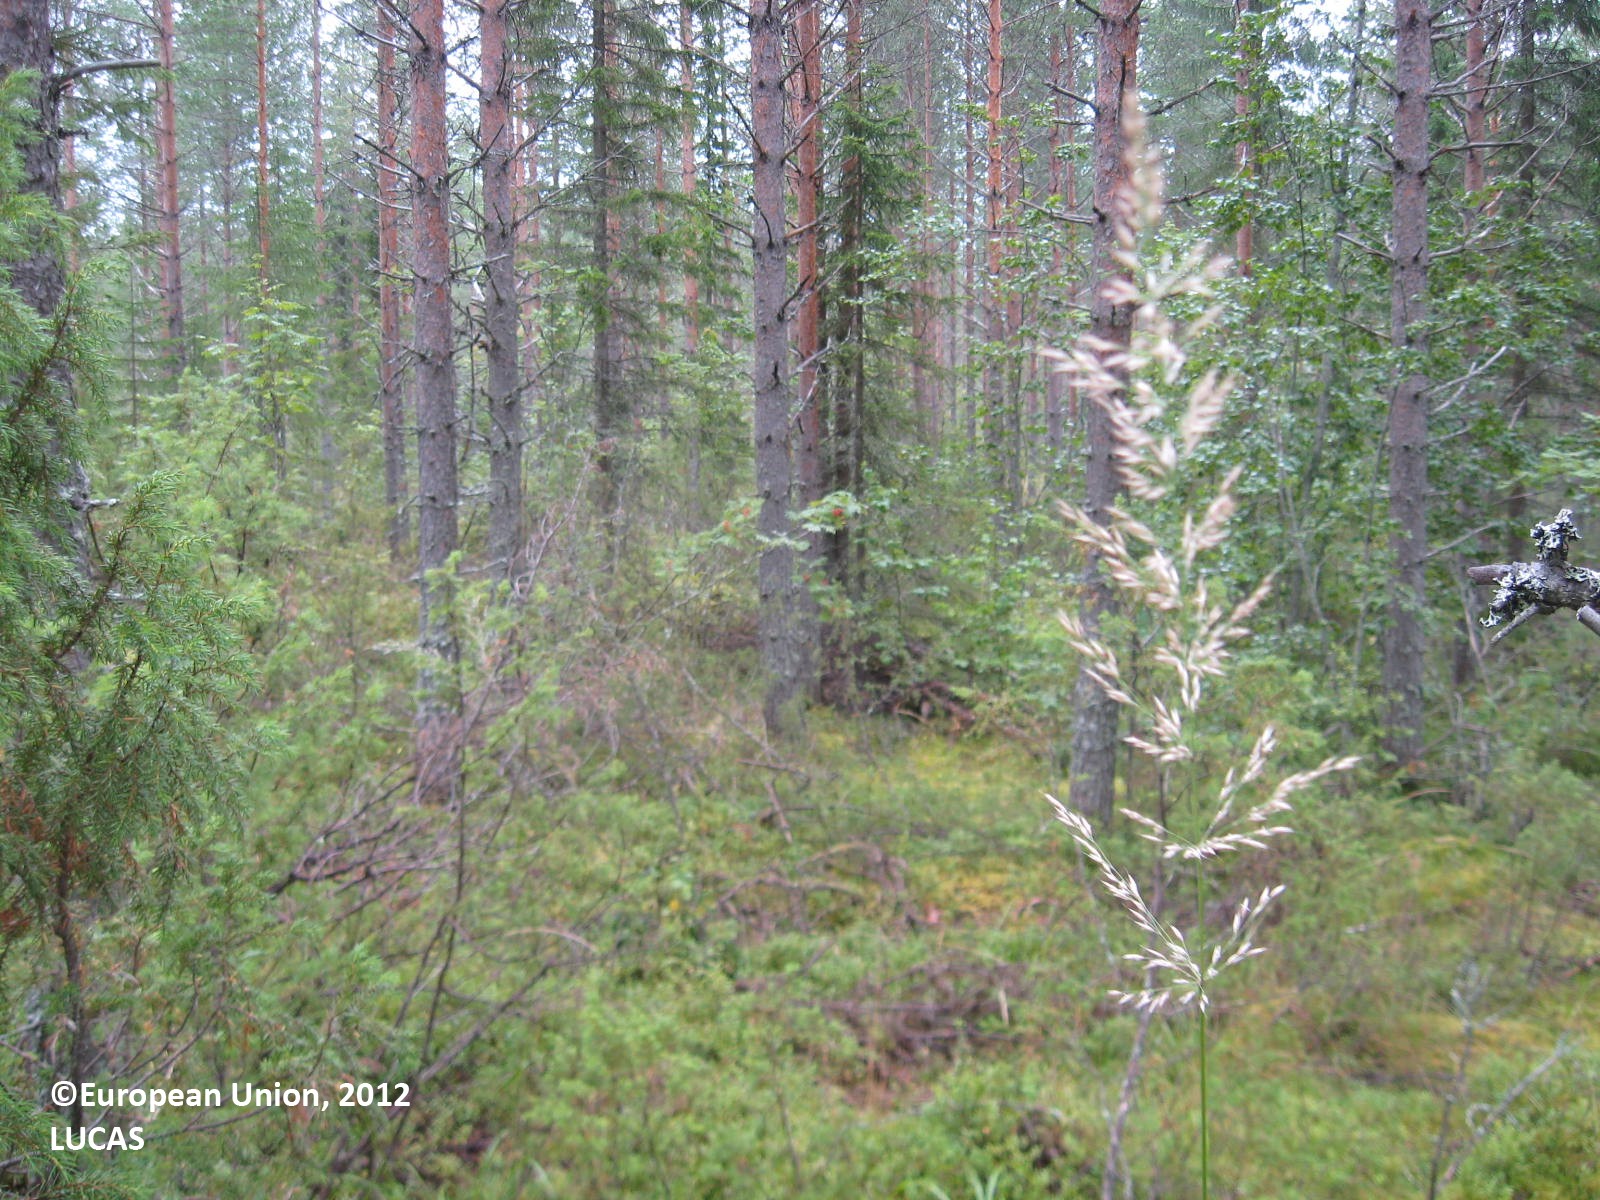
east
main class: Woodland
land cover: Pine dominated coniferous woodland
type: boreal forest
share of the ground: > 75 %
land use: Forestry
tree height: > 5 m
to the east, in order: Pine dominated coniferous woodland; Tracks; Pine dominated coniferous woodland; Ditches and canals; Pine dominated coniferous woodland; Other mixed woodland
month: August
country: FI
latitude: 63.4999
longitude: 29.8261
